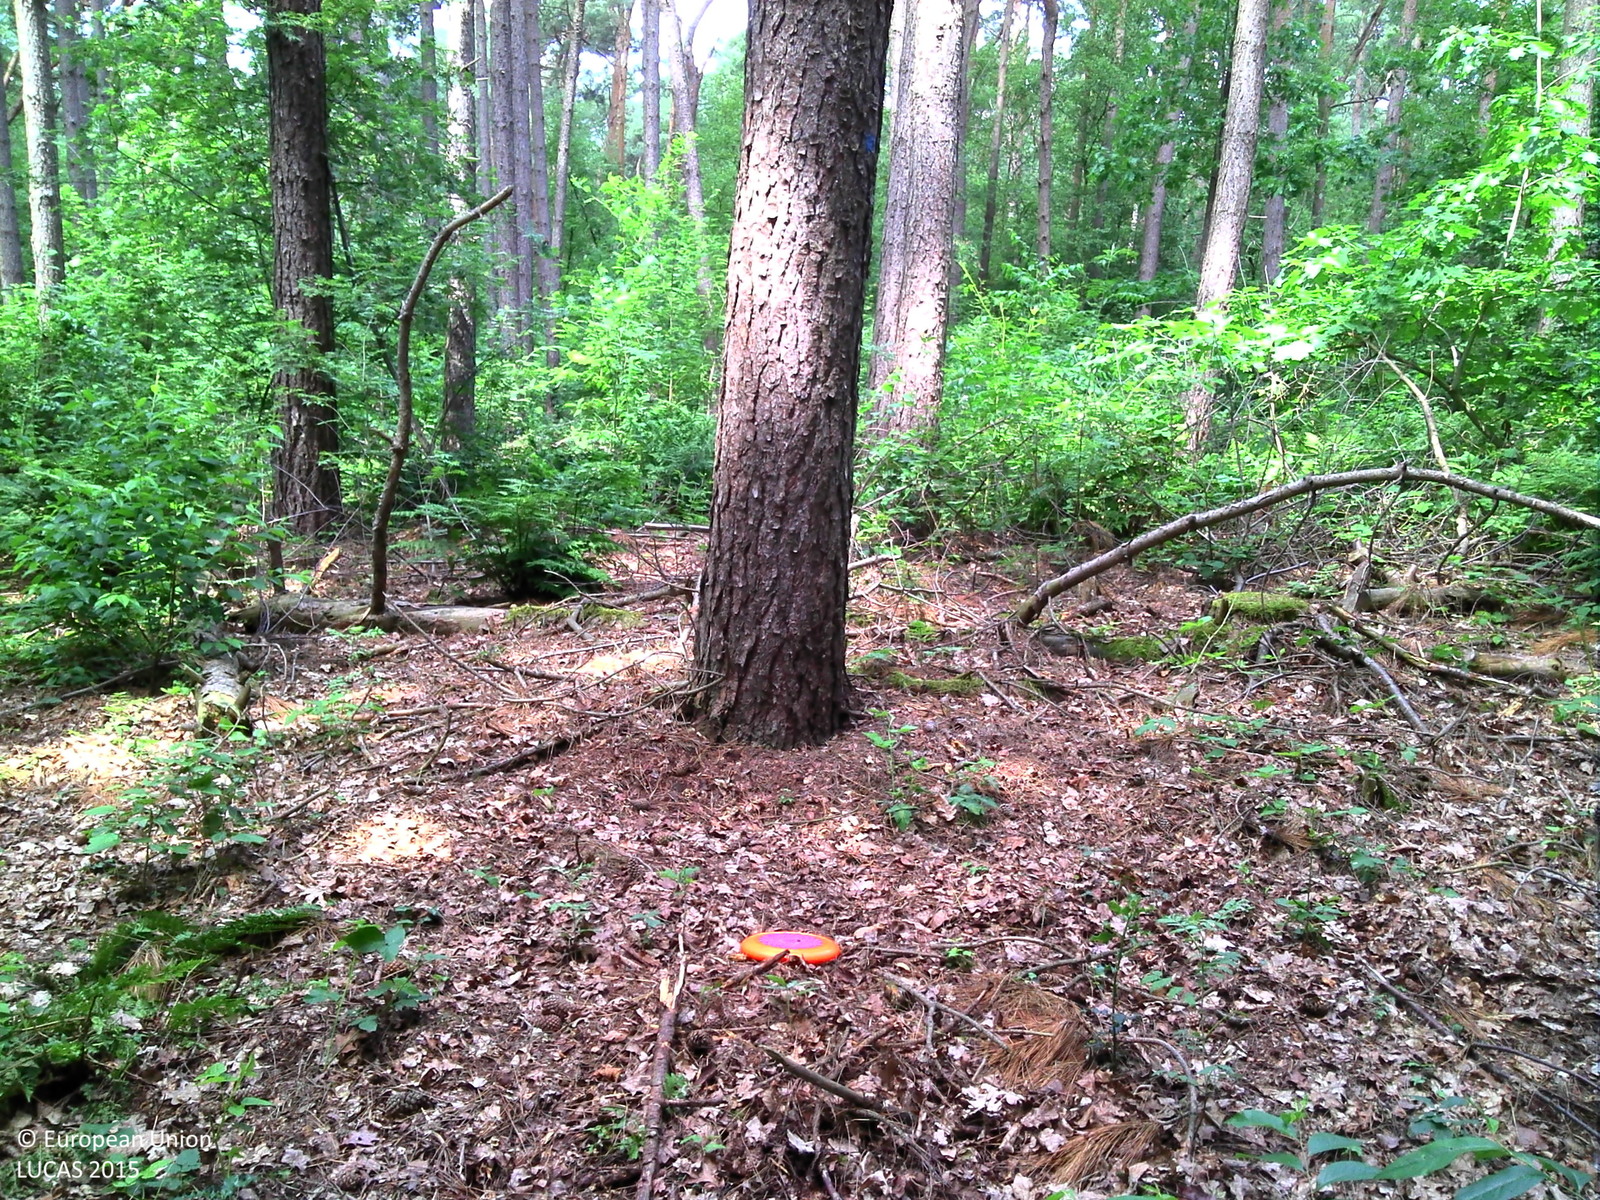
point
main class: Woodland
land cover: Pine dominated mixed woodland
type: exotic forest
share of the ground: > 75 %
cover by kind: coniferous forest trees 60 %, broadleaved forest trees 40 %
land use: Forestry
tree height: > 5 m
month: June
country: BE
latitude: 50.9310
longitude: 5.6872
